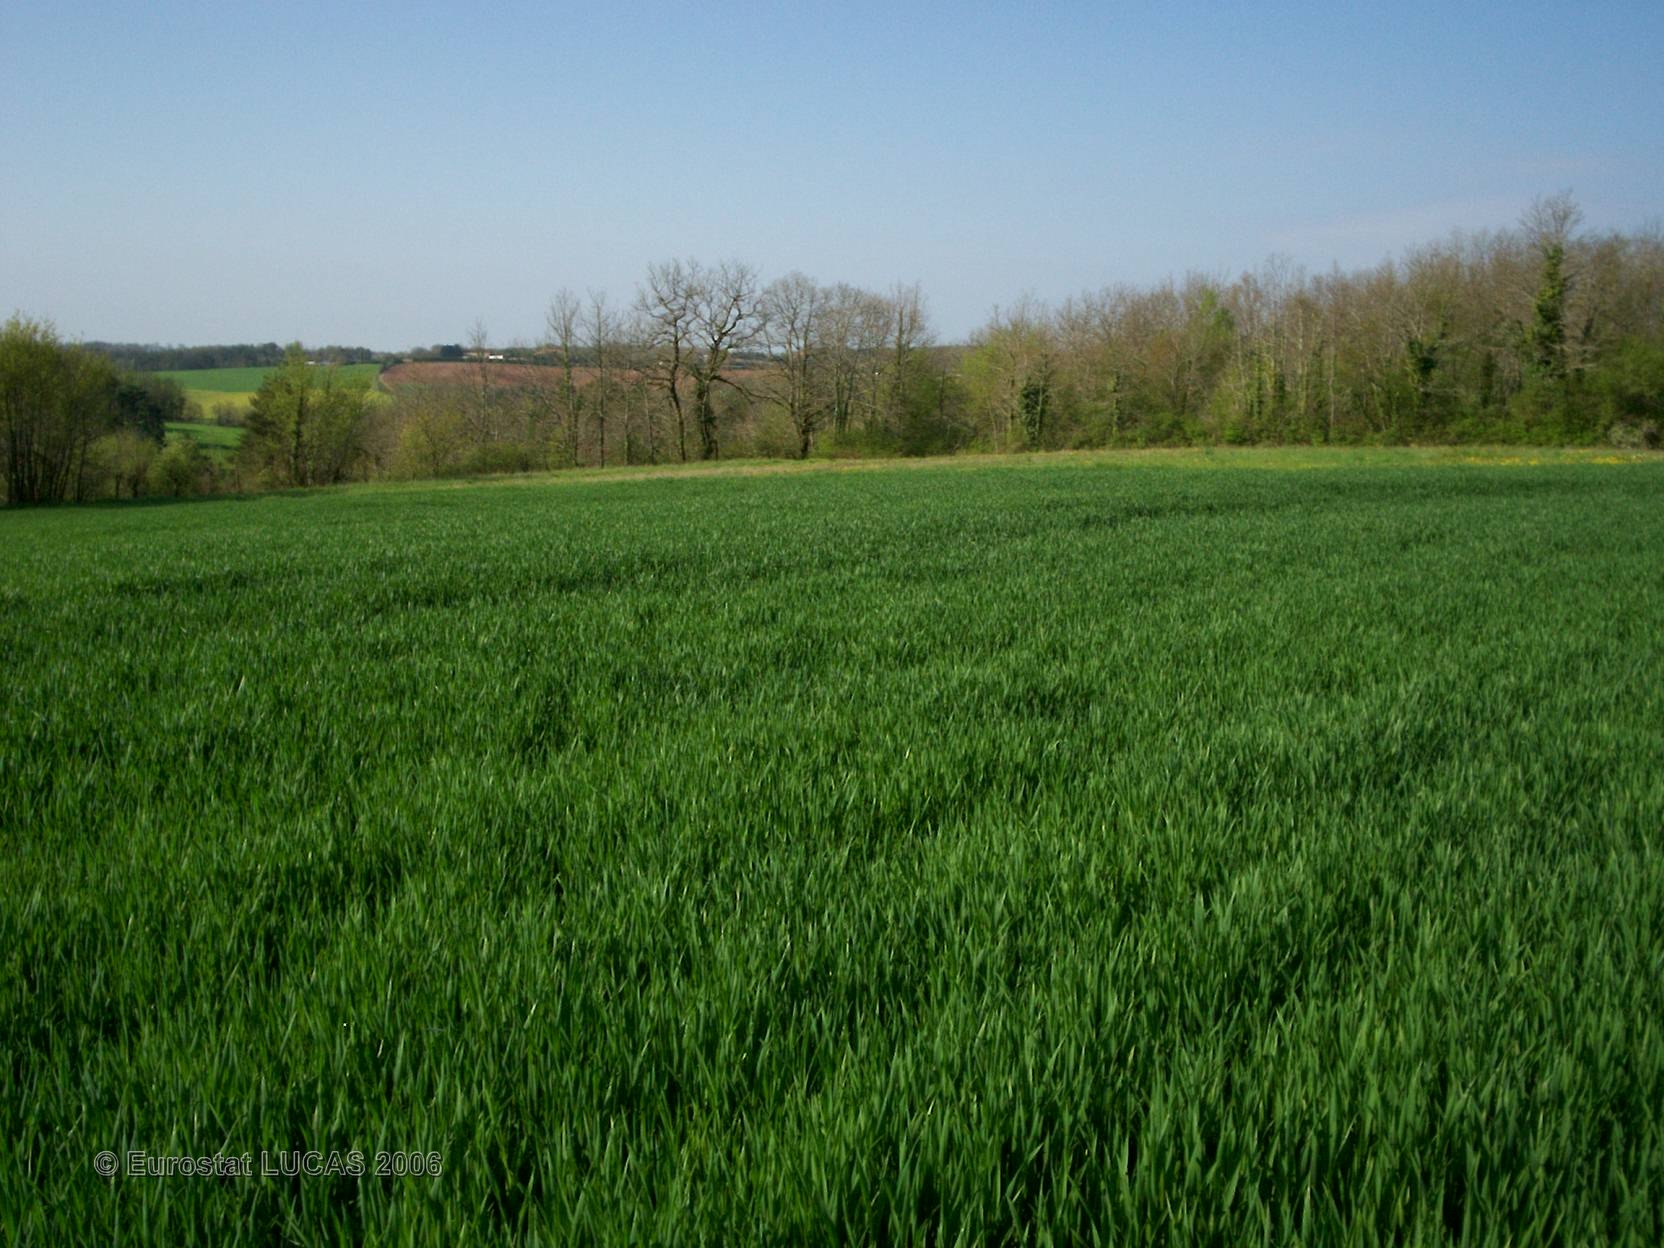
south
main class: Cropland
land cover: Common wheat
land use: Agriculture (excluding fallow land and kitchen gardens)
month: April
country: FR
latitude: 45.5711
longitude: 0.5691
